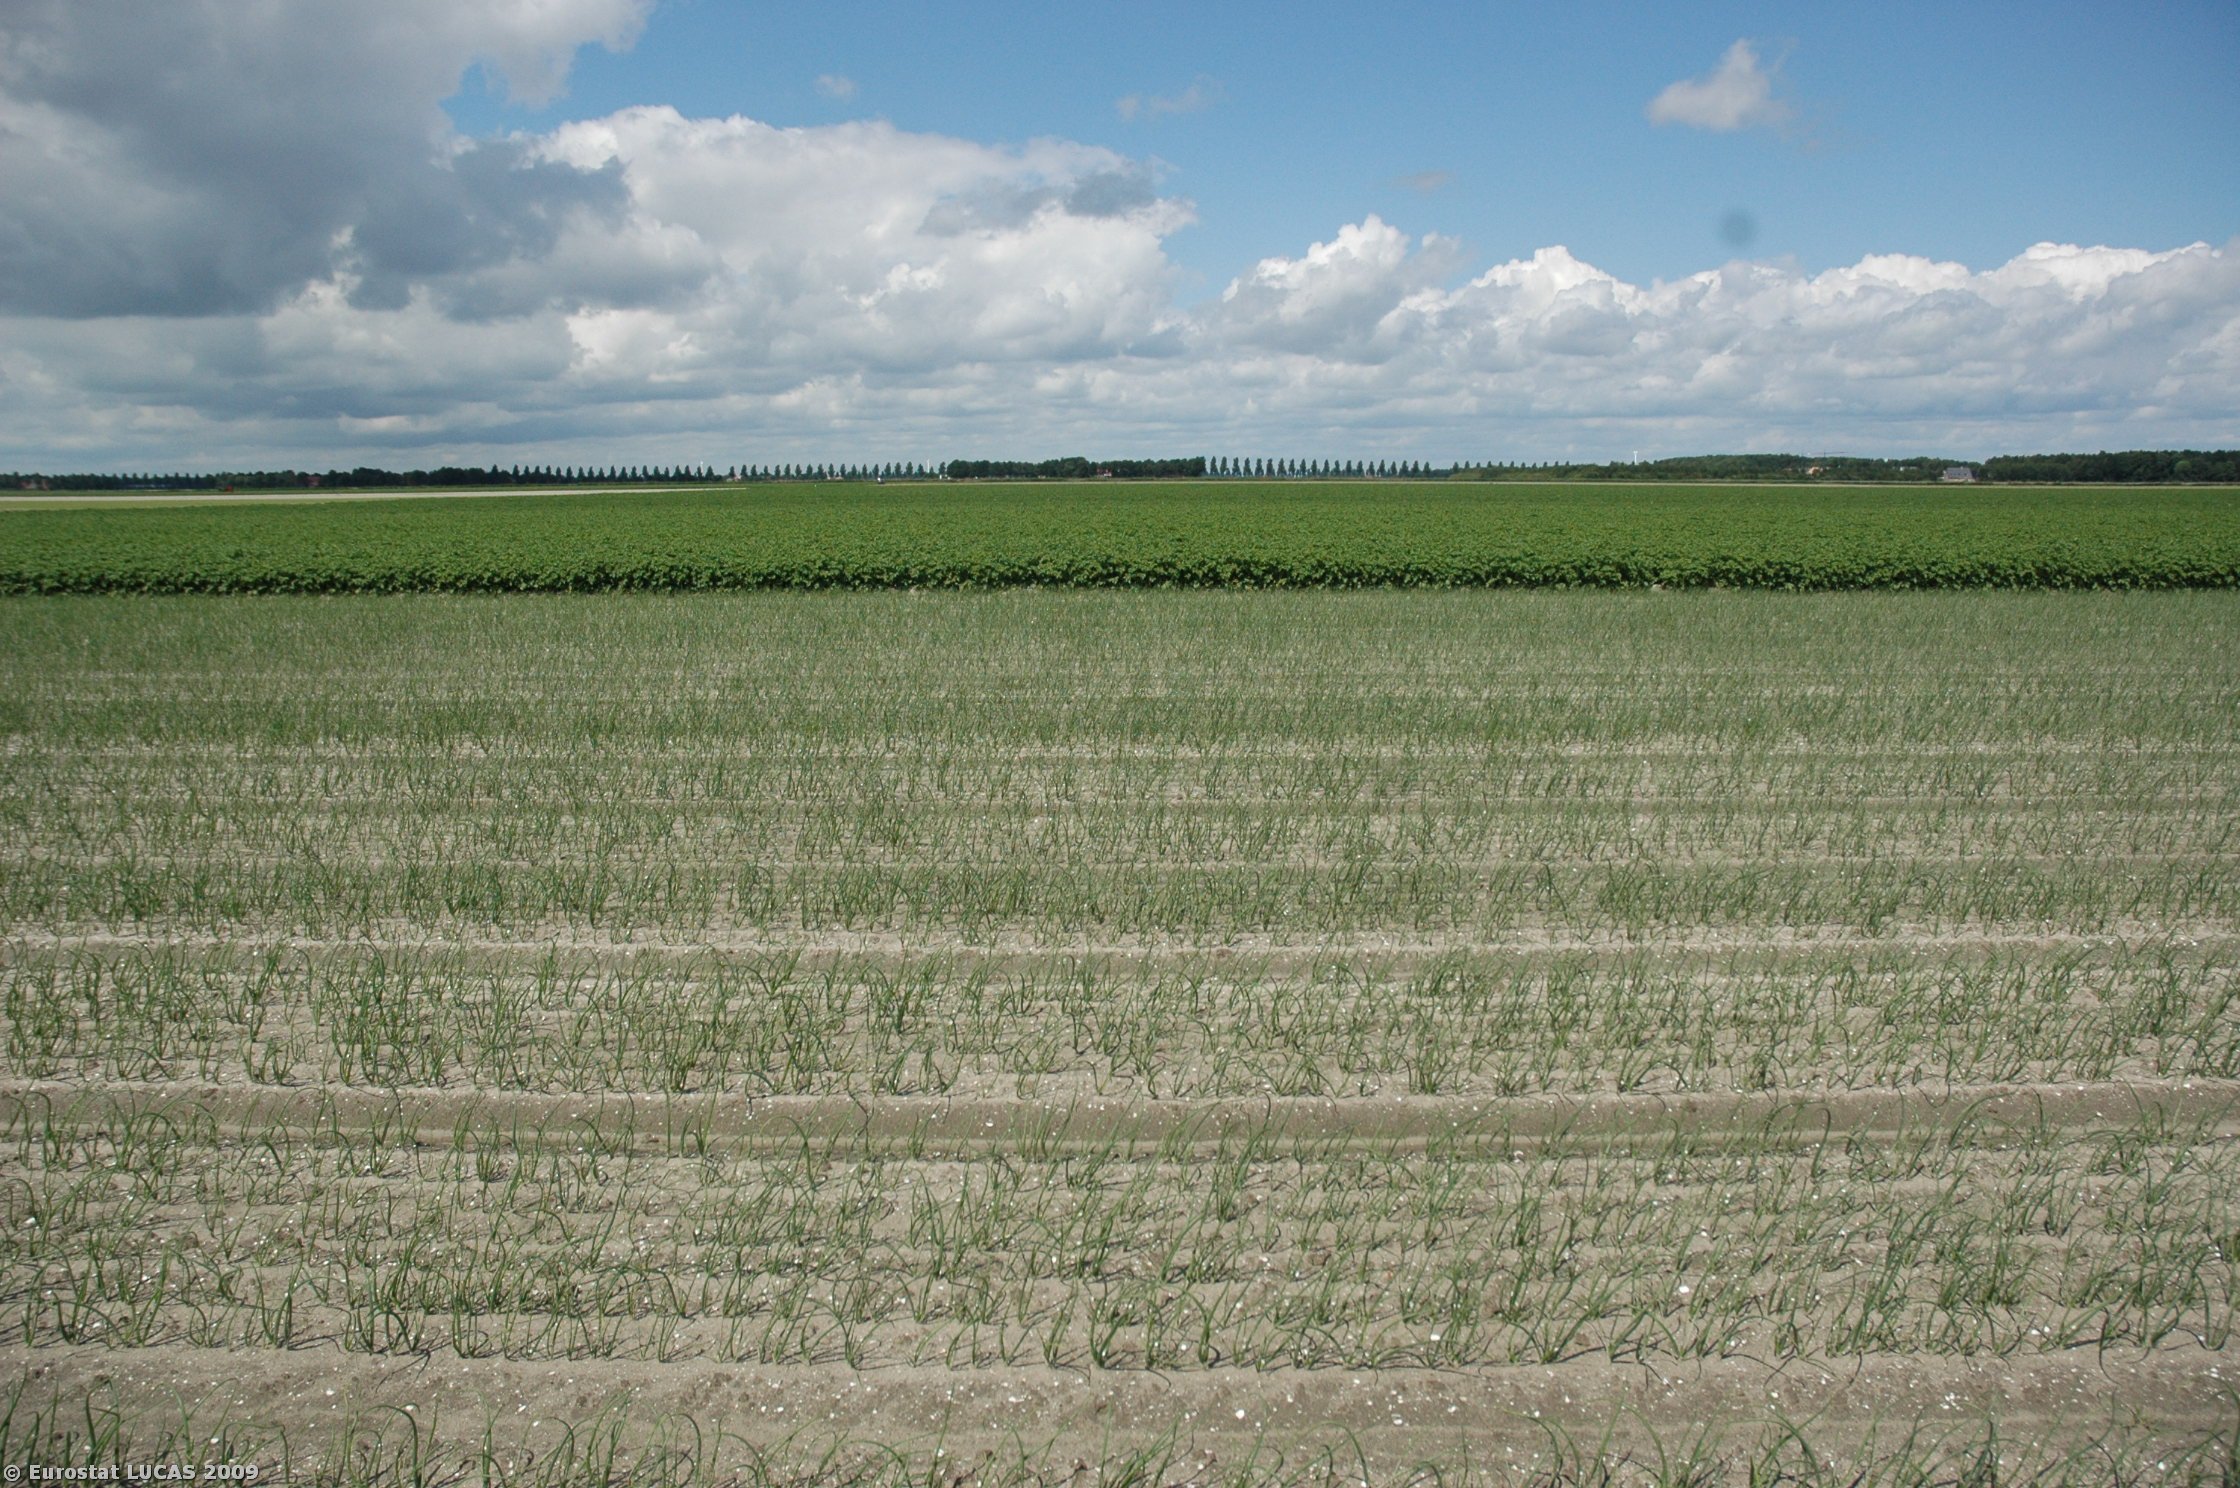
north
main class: Cropland
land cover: Other fresh vegetables
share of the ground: > 75 %
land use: Agriculture (excluding fallow land and kitchen gardens)
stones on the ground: < 10 %
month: June
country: NL
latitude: 52.7112
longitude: 5.6322
